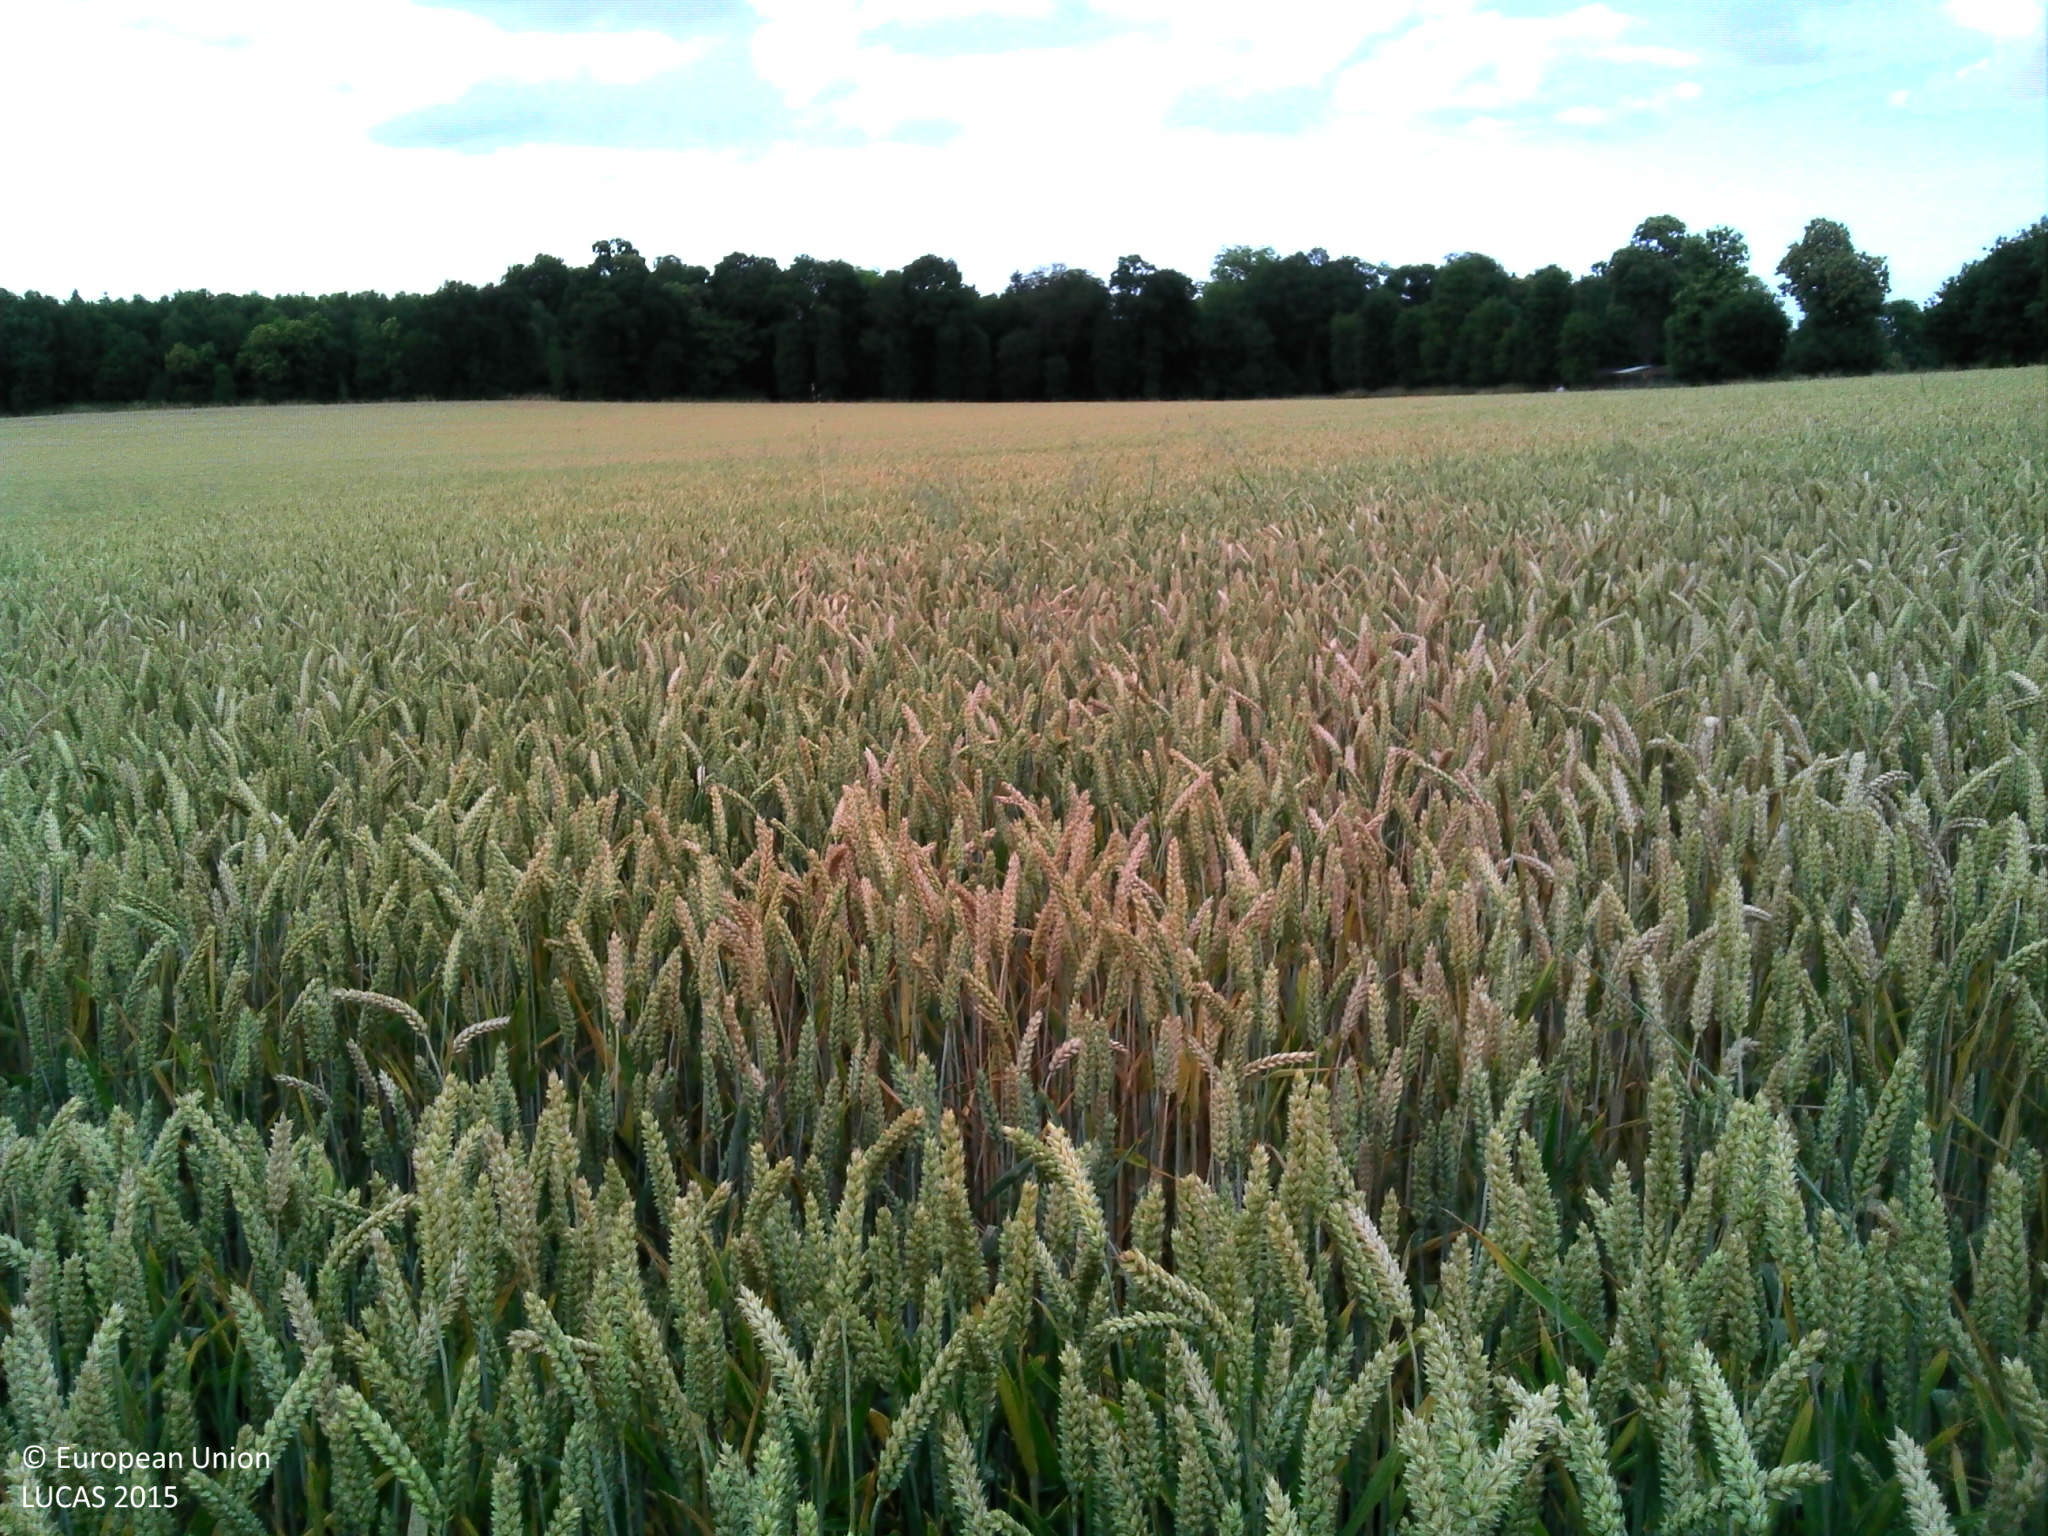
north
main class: Cropland
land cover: Common wheat
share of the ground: > 75 %
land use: Agriculture (excluding fallow land and kitchen gardens)
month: July
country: FR
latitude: 48.2802
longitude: -2.1156
